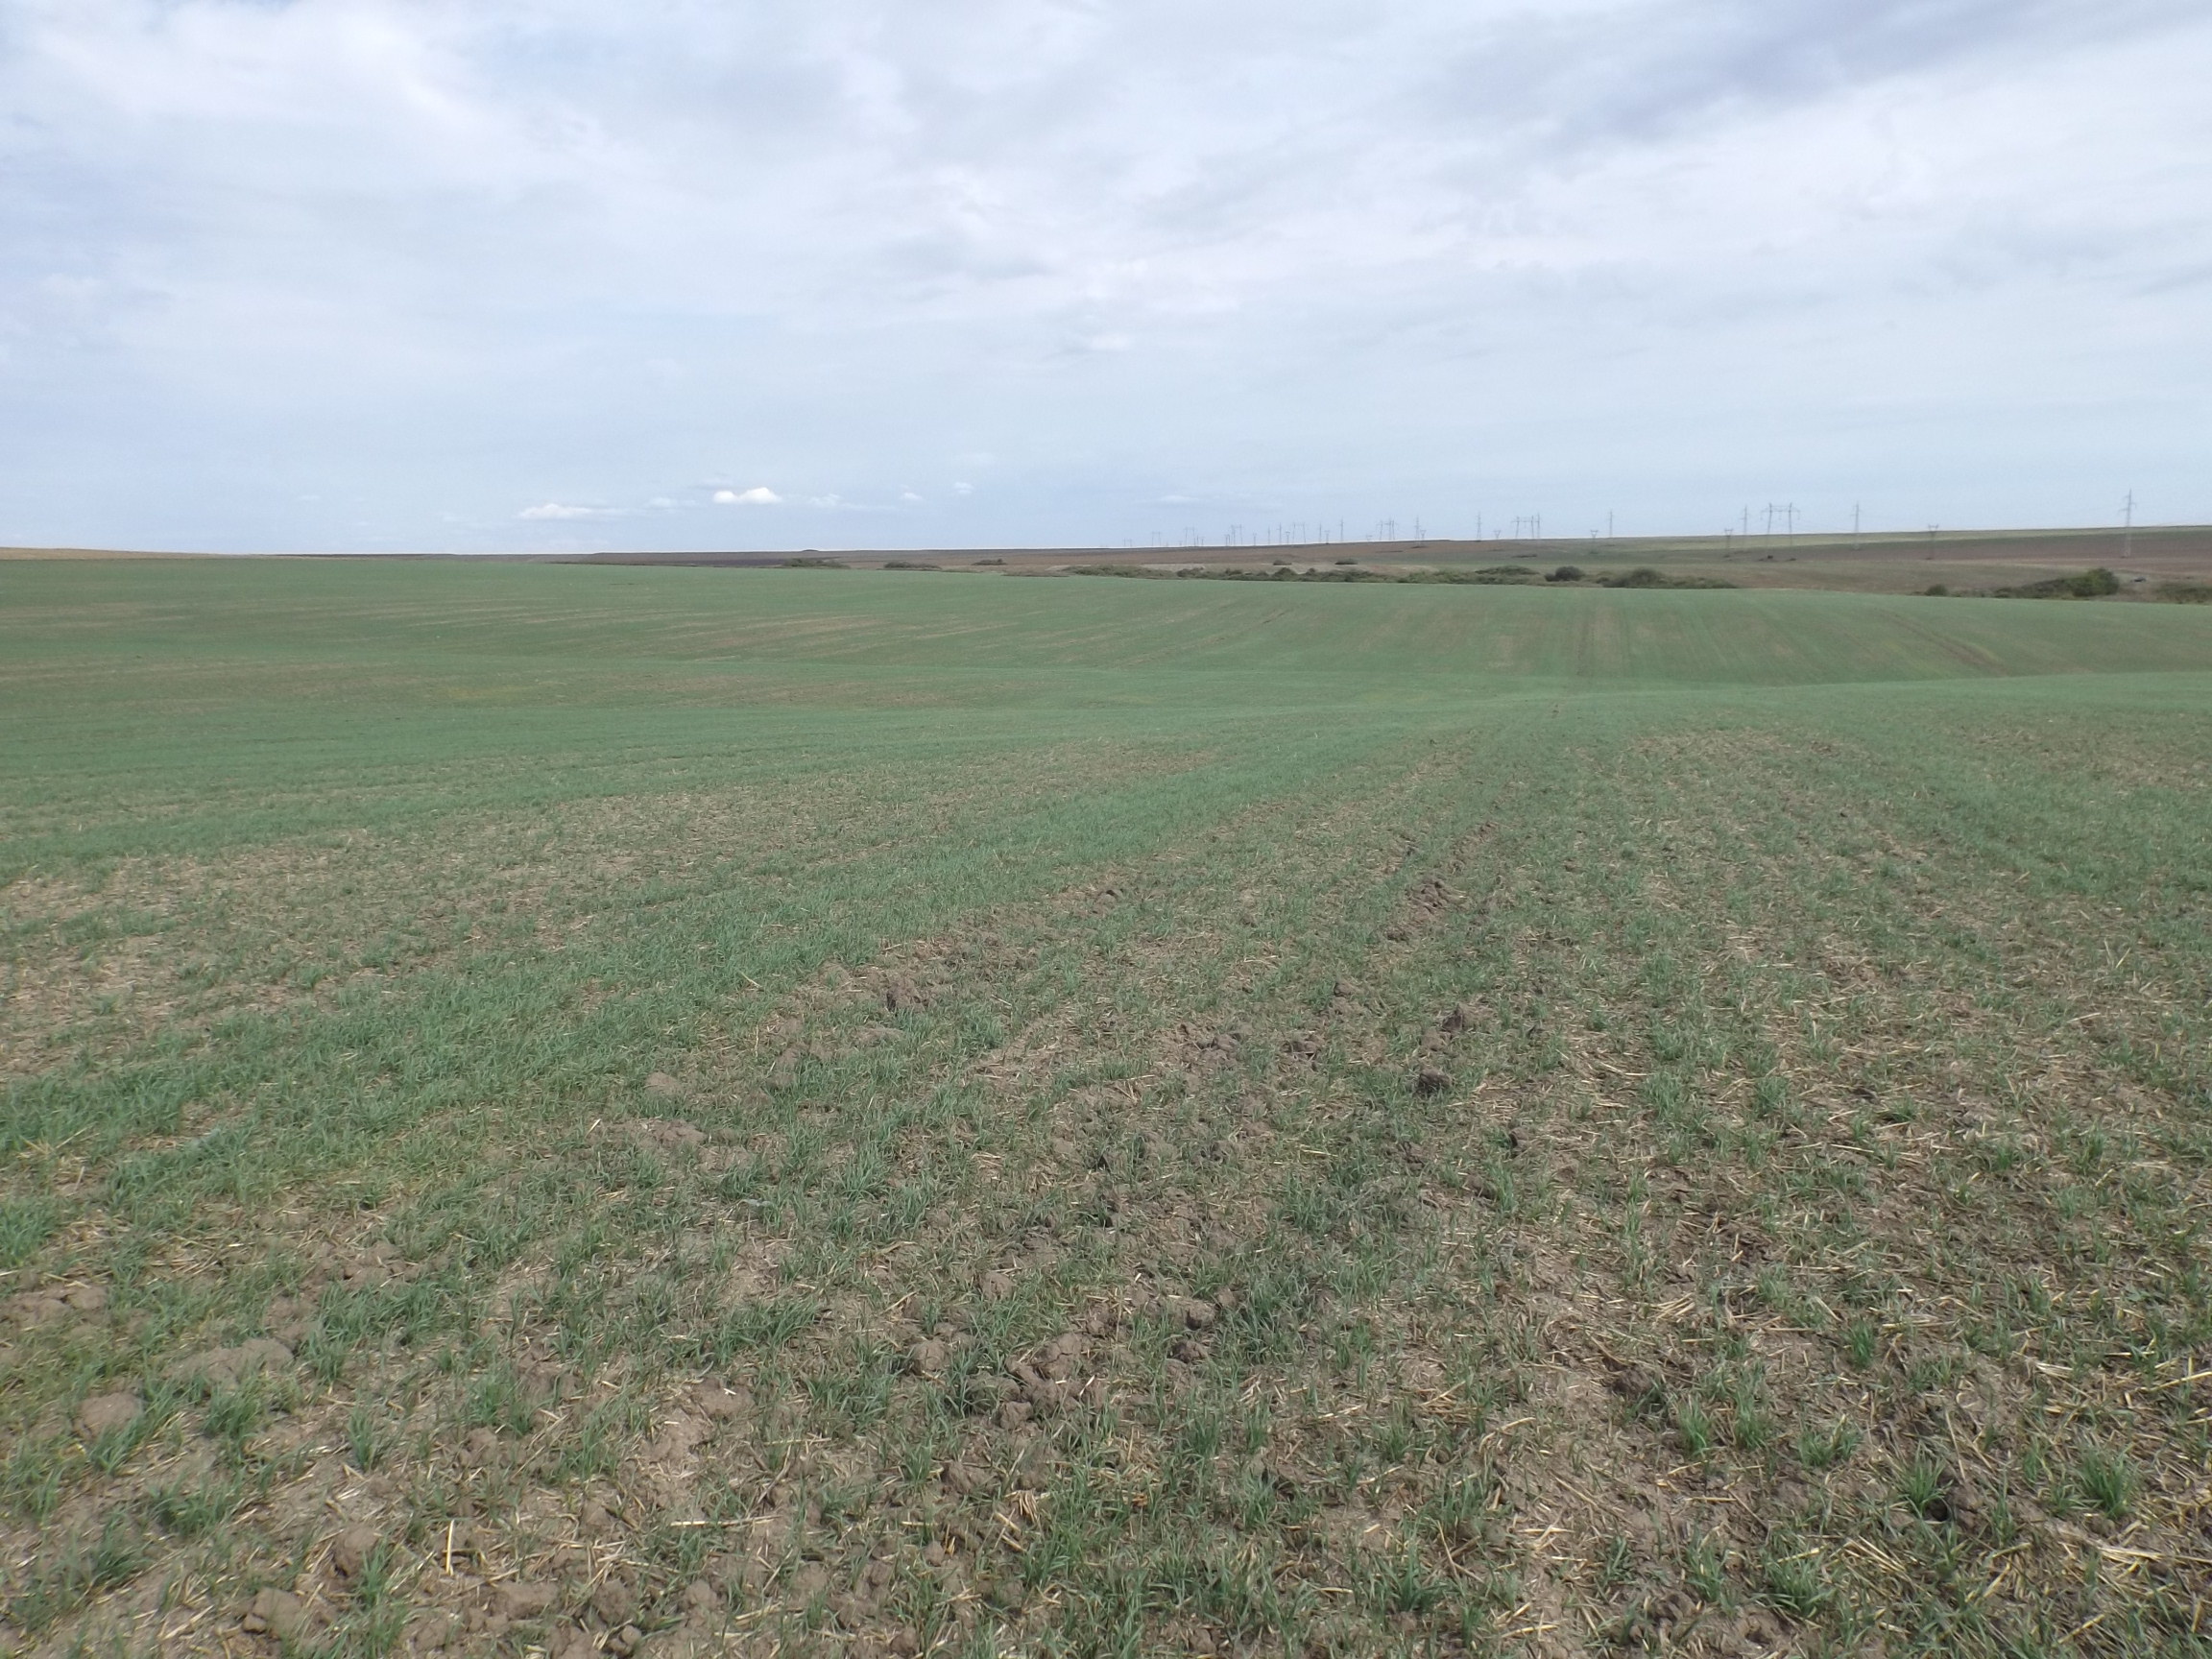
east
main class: Cropland
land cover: Common wheat
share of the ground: < 10 %
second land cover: Spontaneously vegetated surfaces
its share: 10 - 25 %
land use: Agriculture (excluding fallow land and kitchen gardens)
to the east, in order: Common wheat; Spontaneously vegetated surfaces
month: September
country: BG
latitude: 43.3306
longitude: 27.3795
